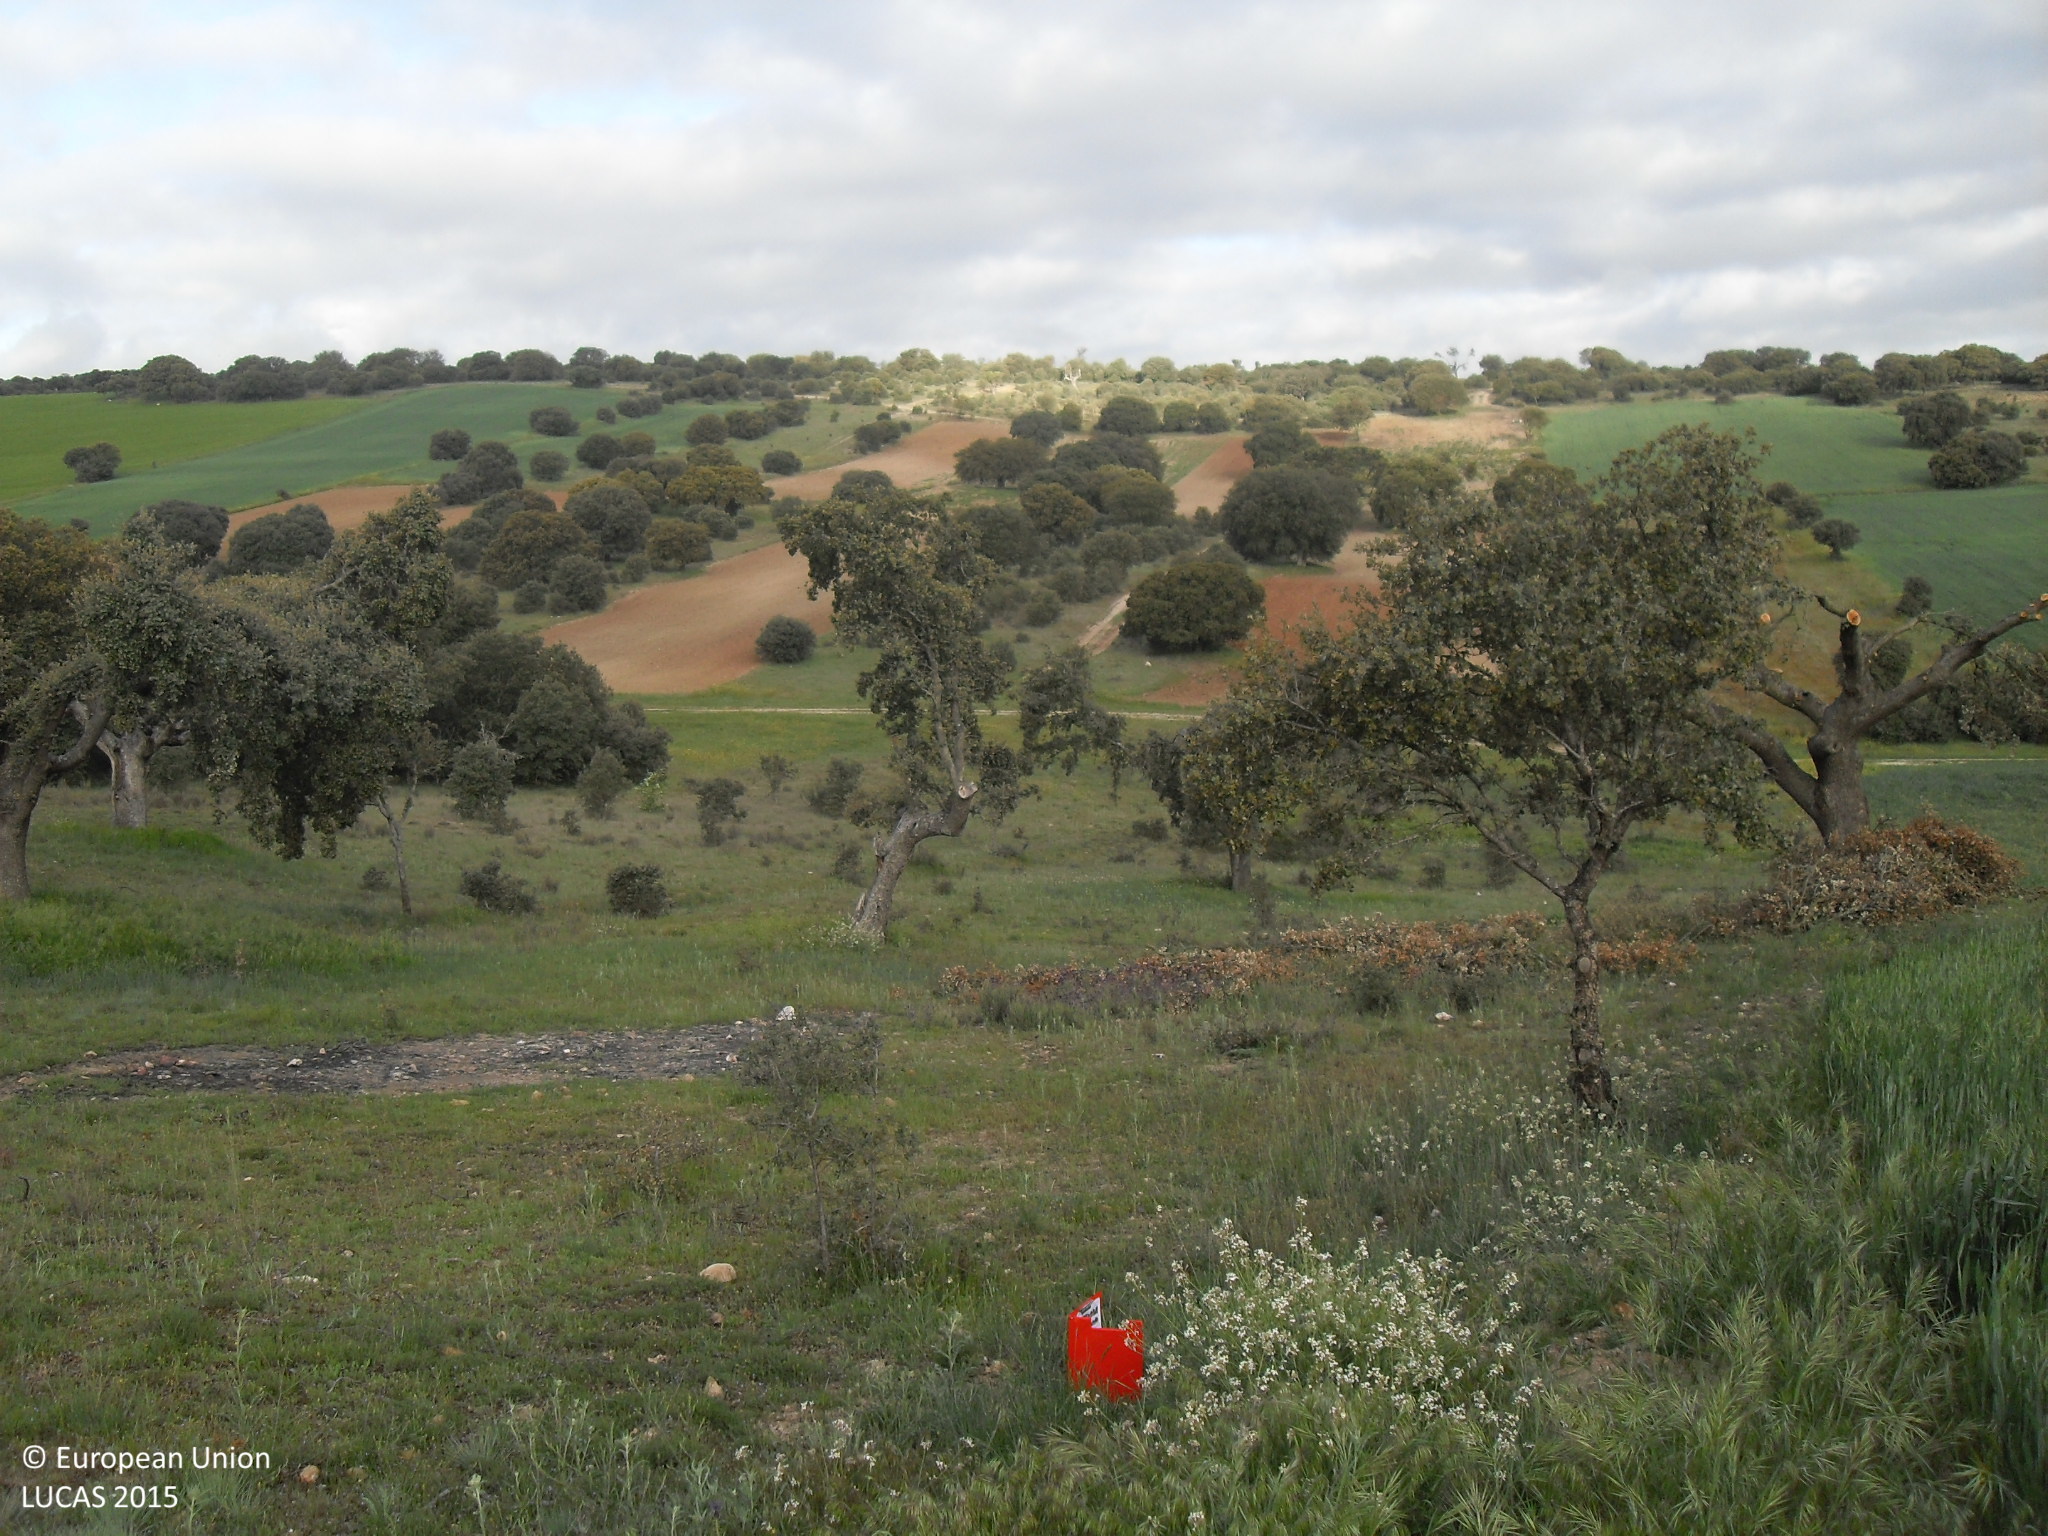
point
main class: Woodland
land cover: Broadleaved woodland
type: broadleaved evergreen forest
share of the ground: 10 - 25 %
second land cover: Grassland without tree/shrub cover
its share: > 75 %
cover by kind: herbaceous plants 85 %, broadleaved forest trees 15 %
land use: Forestry
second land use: Agriculture (excluding fallow land and kitchen gardens)
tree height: > 5 m
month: May
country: ES
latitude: 40.8122
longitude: -5.1327
